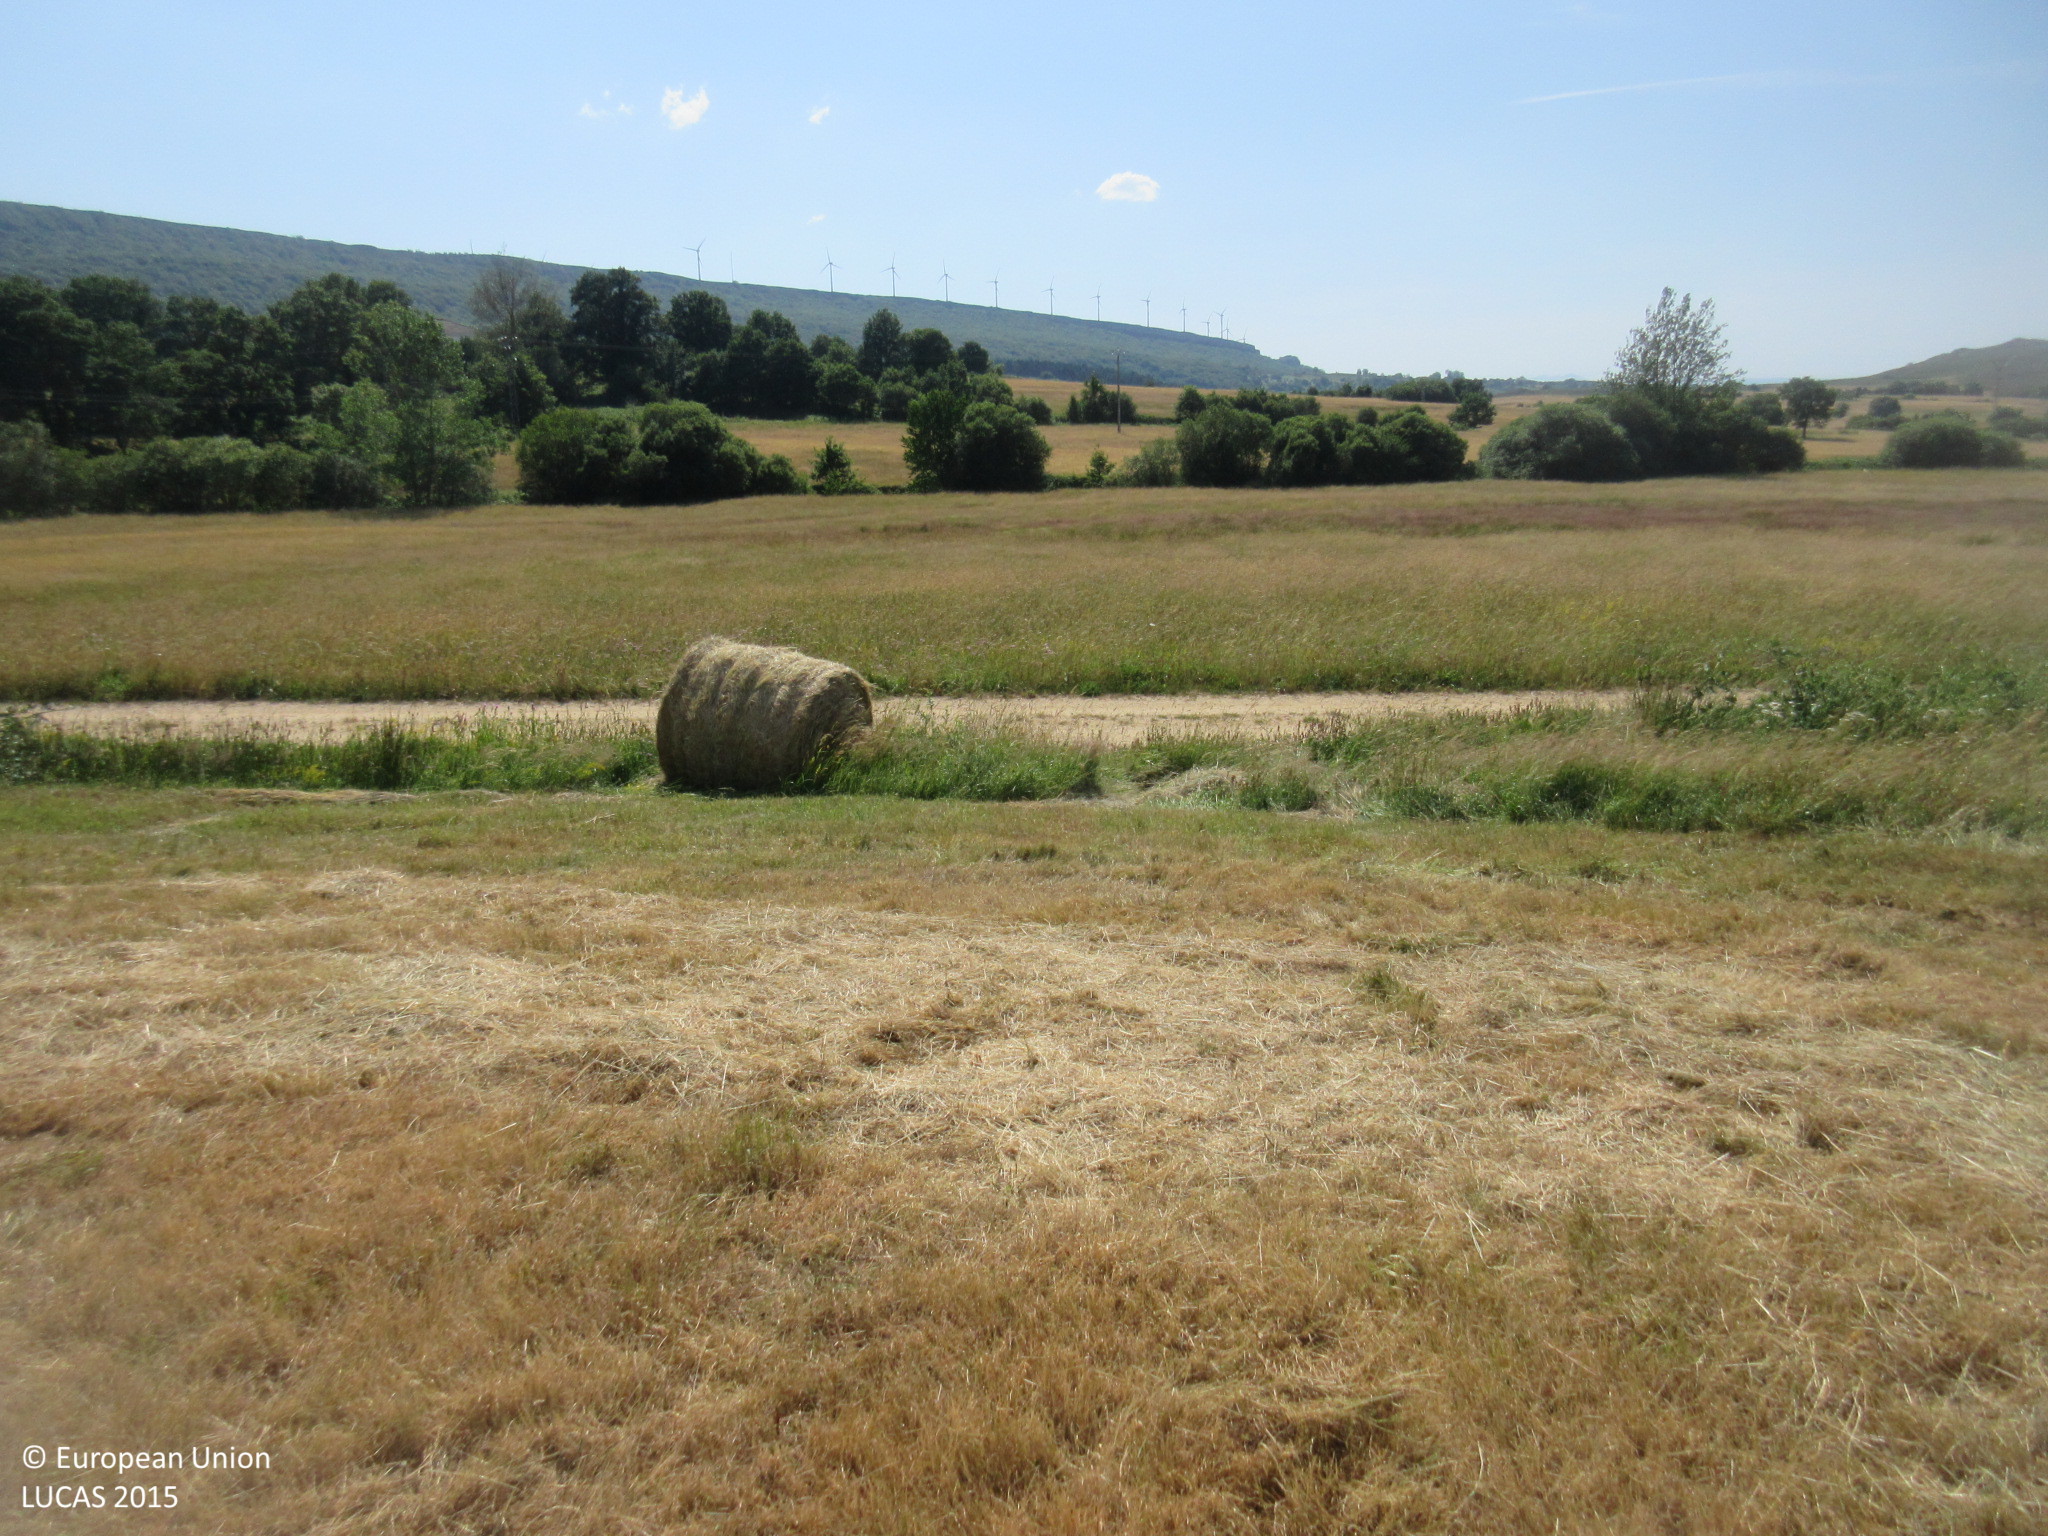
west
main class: Grassland
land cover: Grassland without tree/shrub cover
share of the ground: > 75 %
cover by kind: herbaceous plants 100 %
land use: Agriculture (excluding fallow land and kitchen gardens)
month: July
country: ES
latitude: 42.9614
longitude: -3.8362
